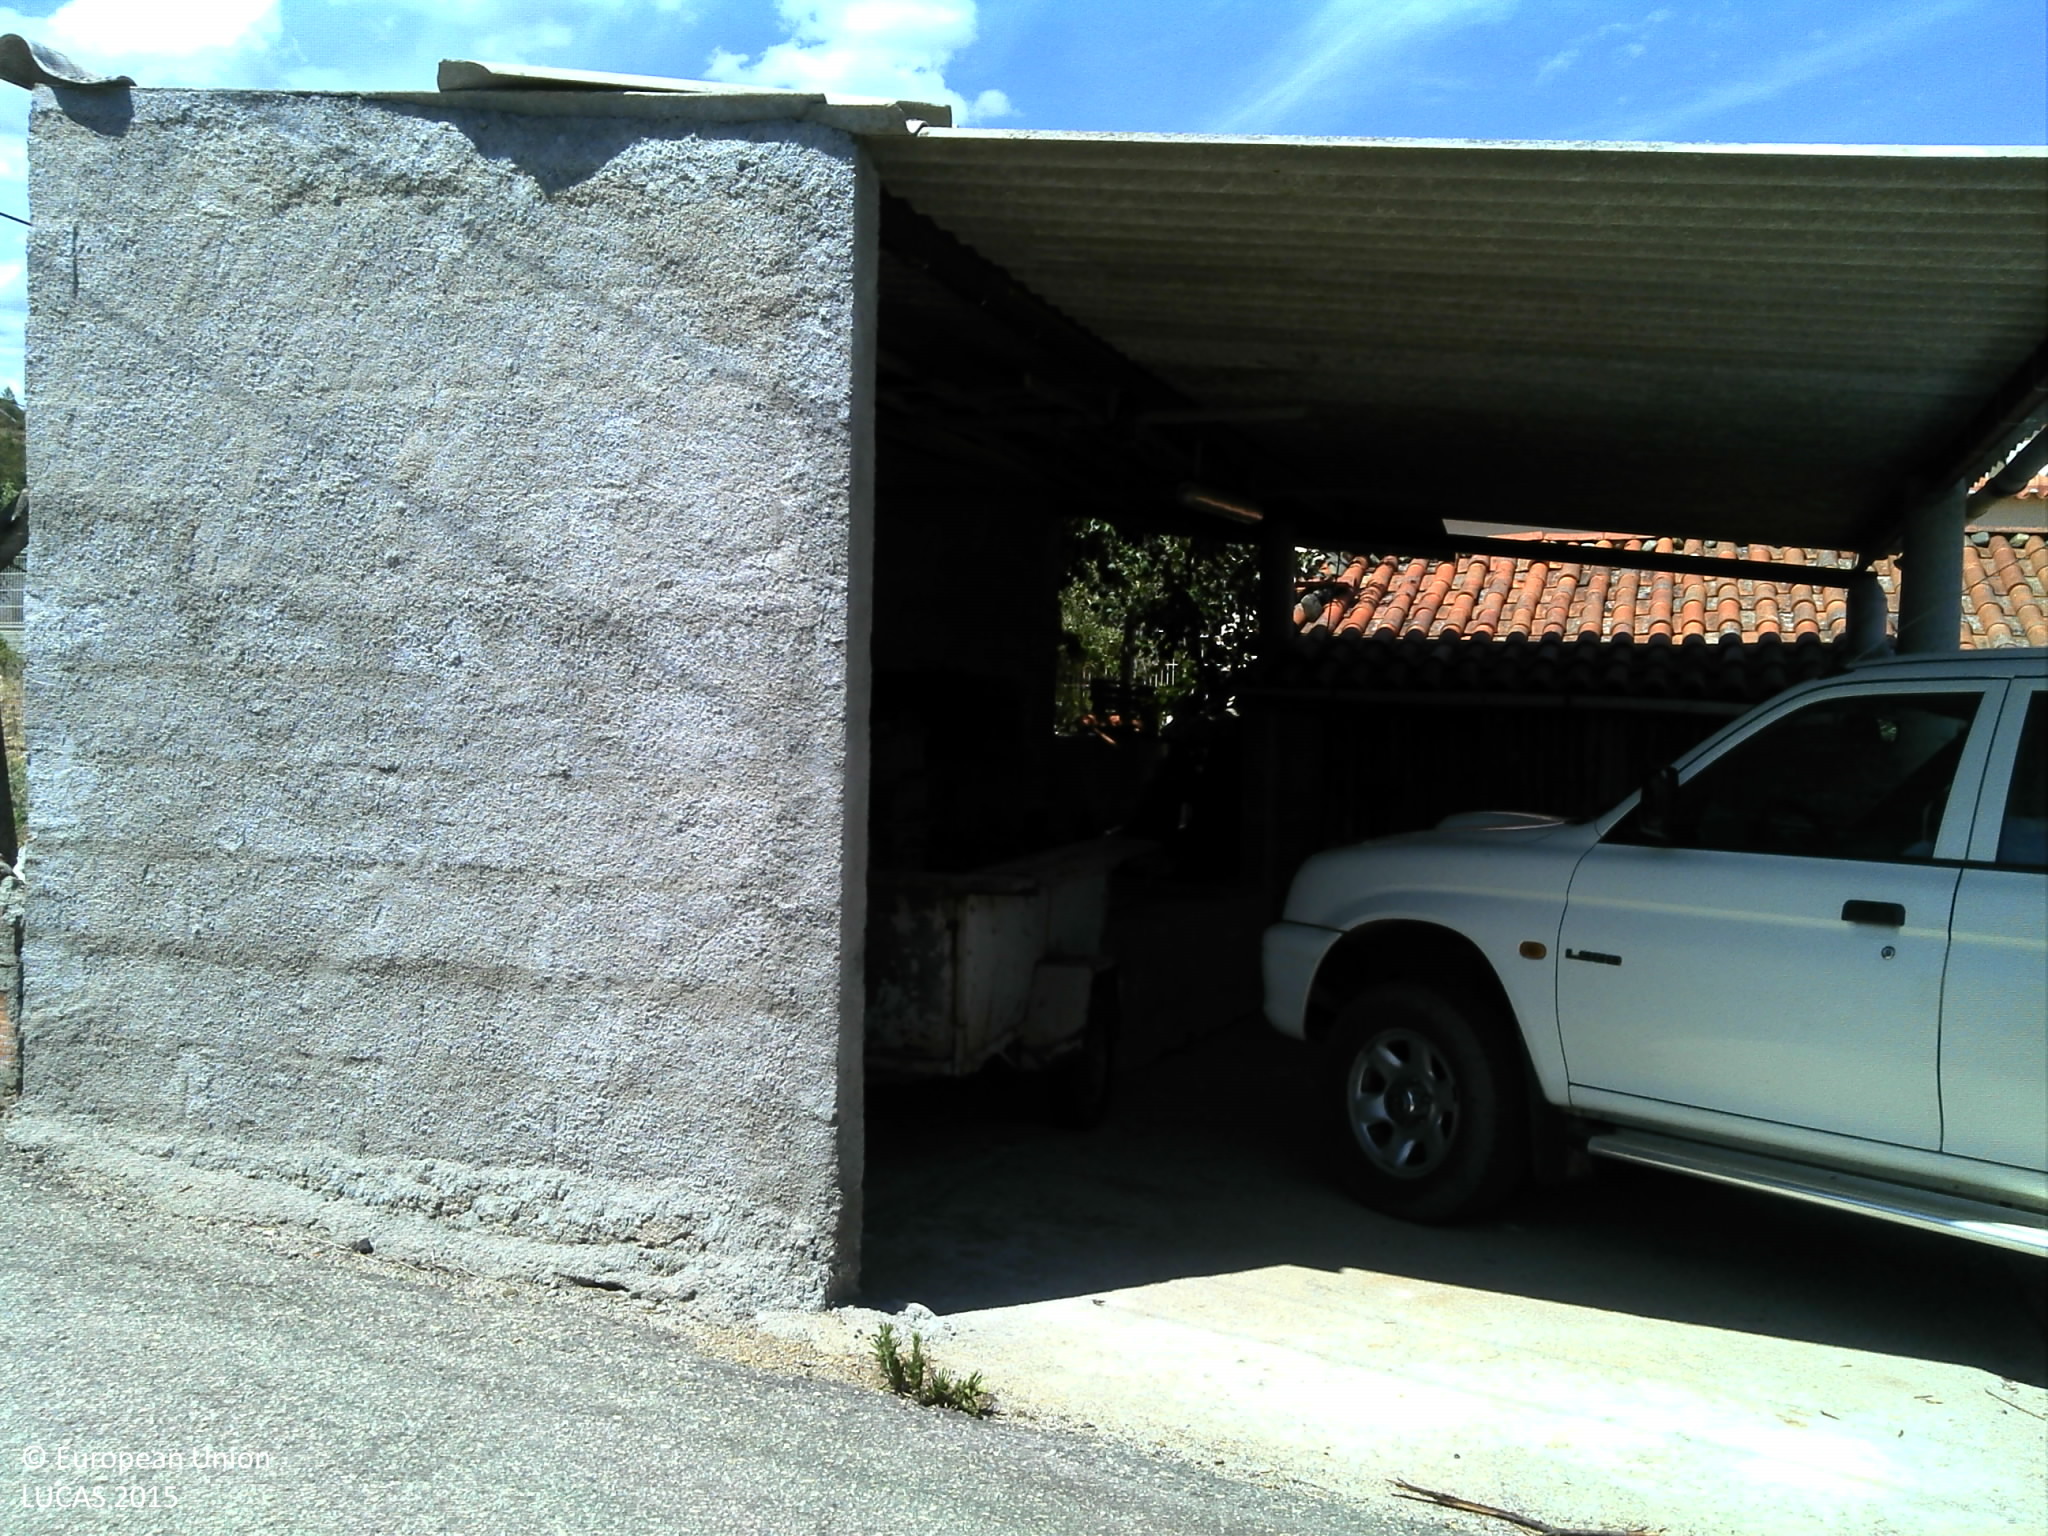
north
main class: Cropland
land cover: Apple fruit
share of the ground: 10 - 25 %
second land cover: Other fresh vegetables
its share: 10 - 25 %
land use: Kitchen garden
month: July
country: PT
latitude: 39.8150
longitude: -7.7566
